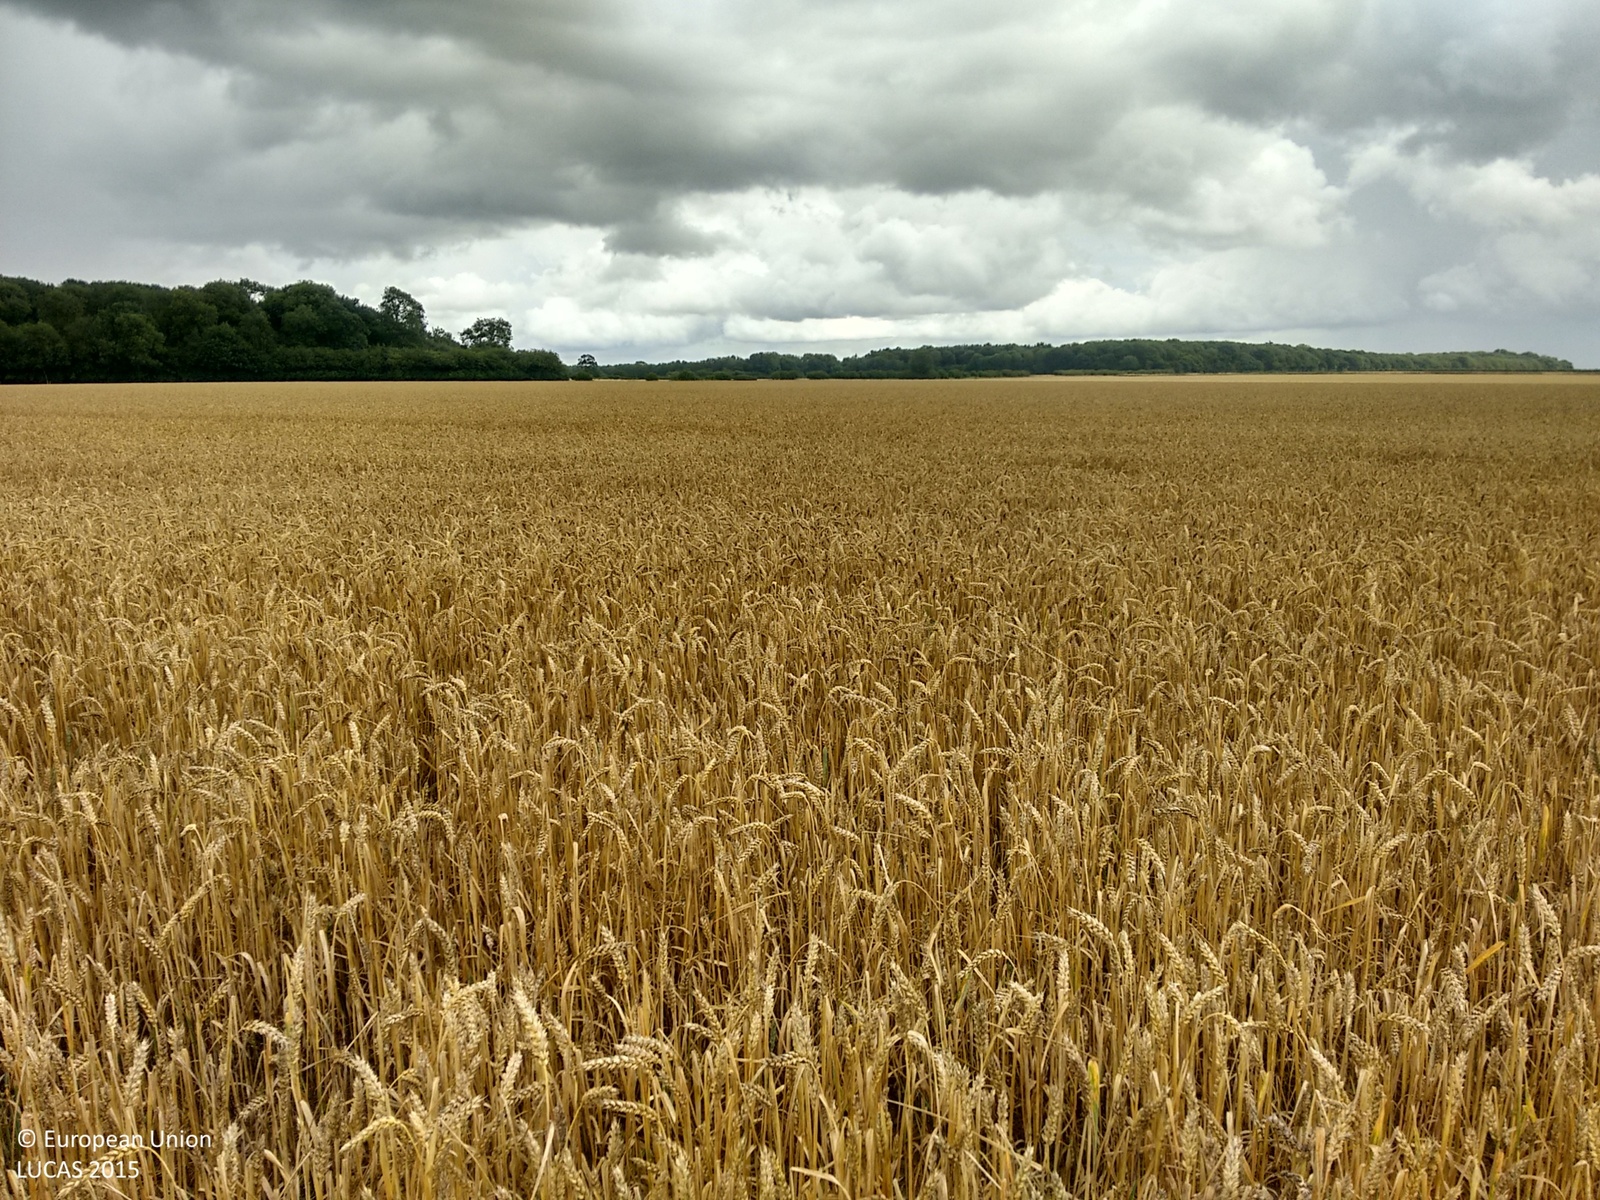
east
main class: Cropland
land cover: Common wheat
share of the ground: > 75 %
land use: Agriculture (excluding fallow land and kitchen gardens)
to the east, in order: Common wheat
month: August
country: GB
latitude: 52.1884
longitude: 0.4198
